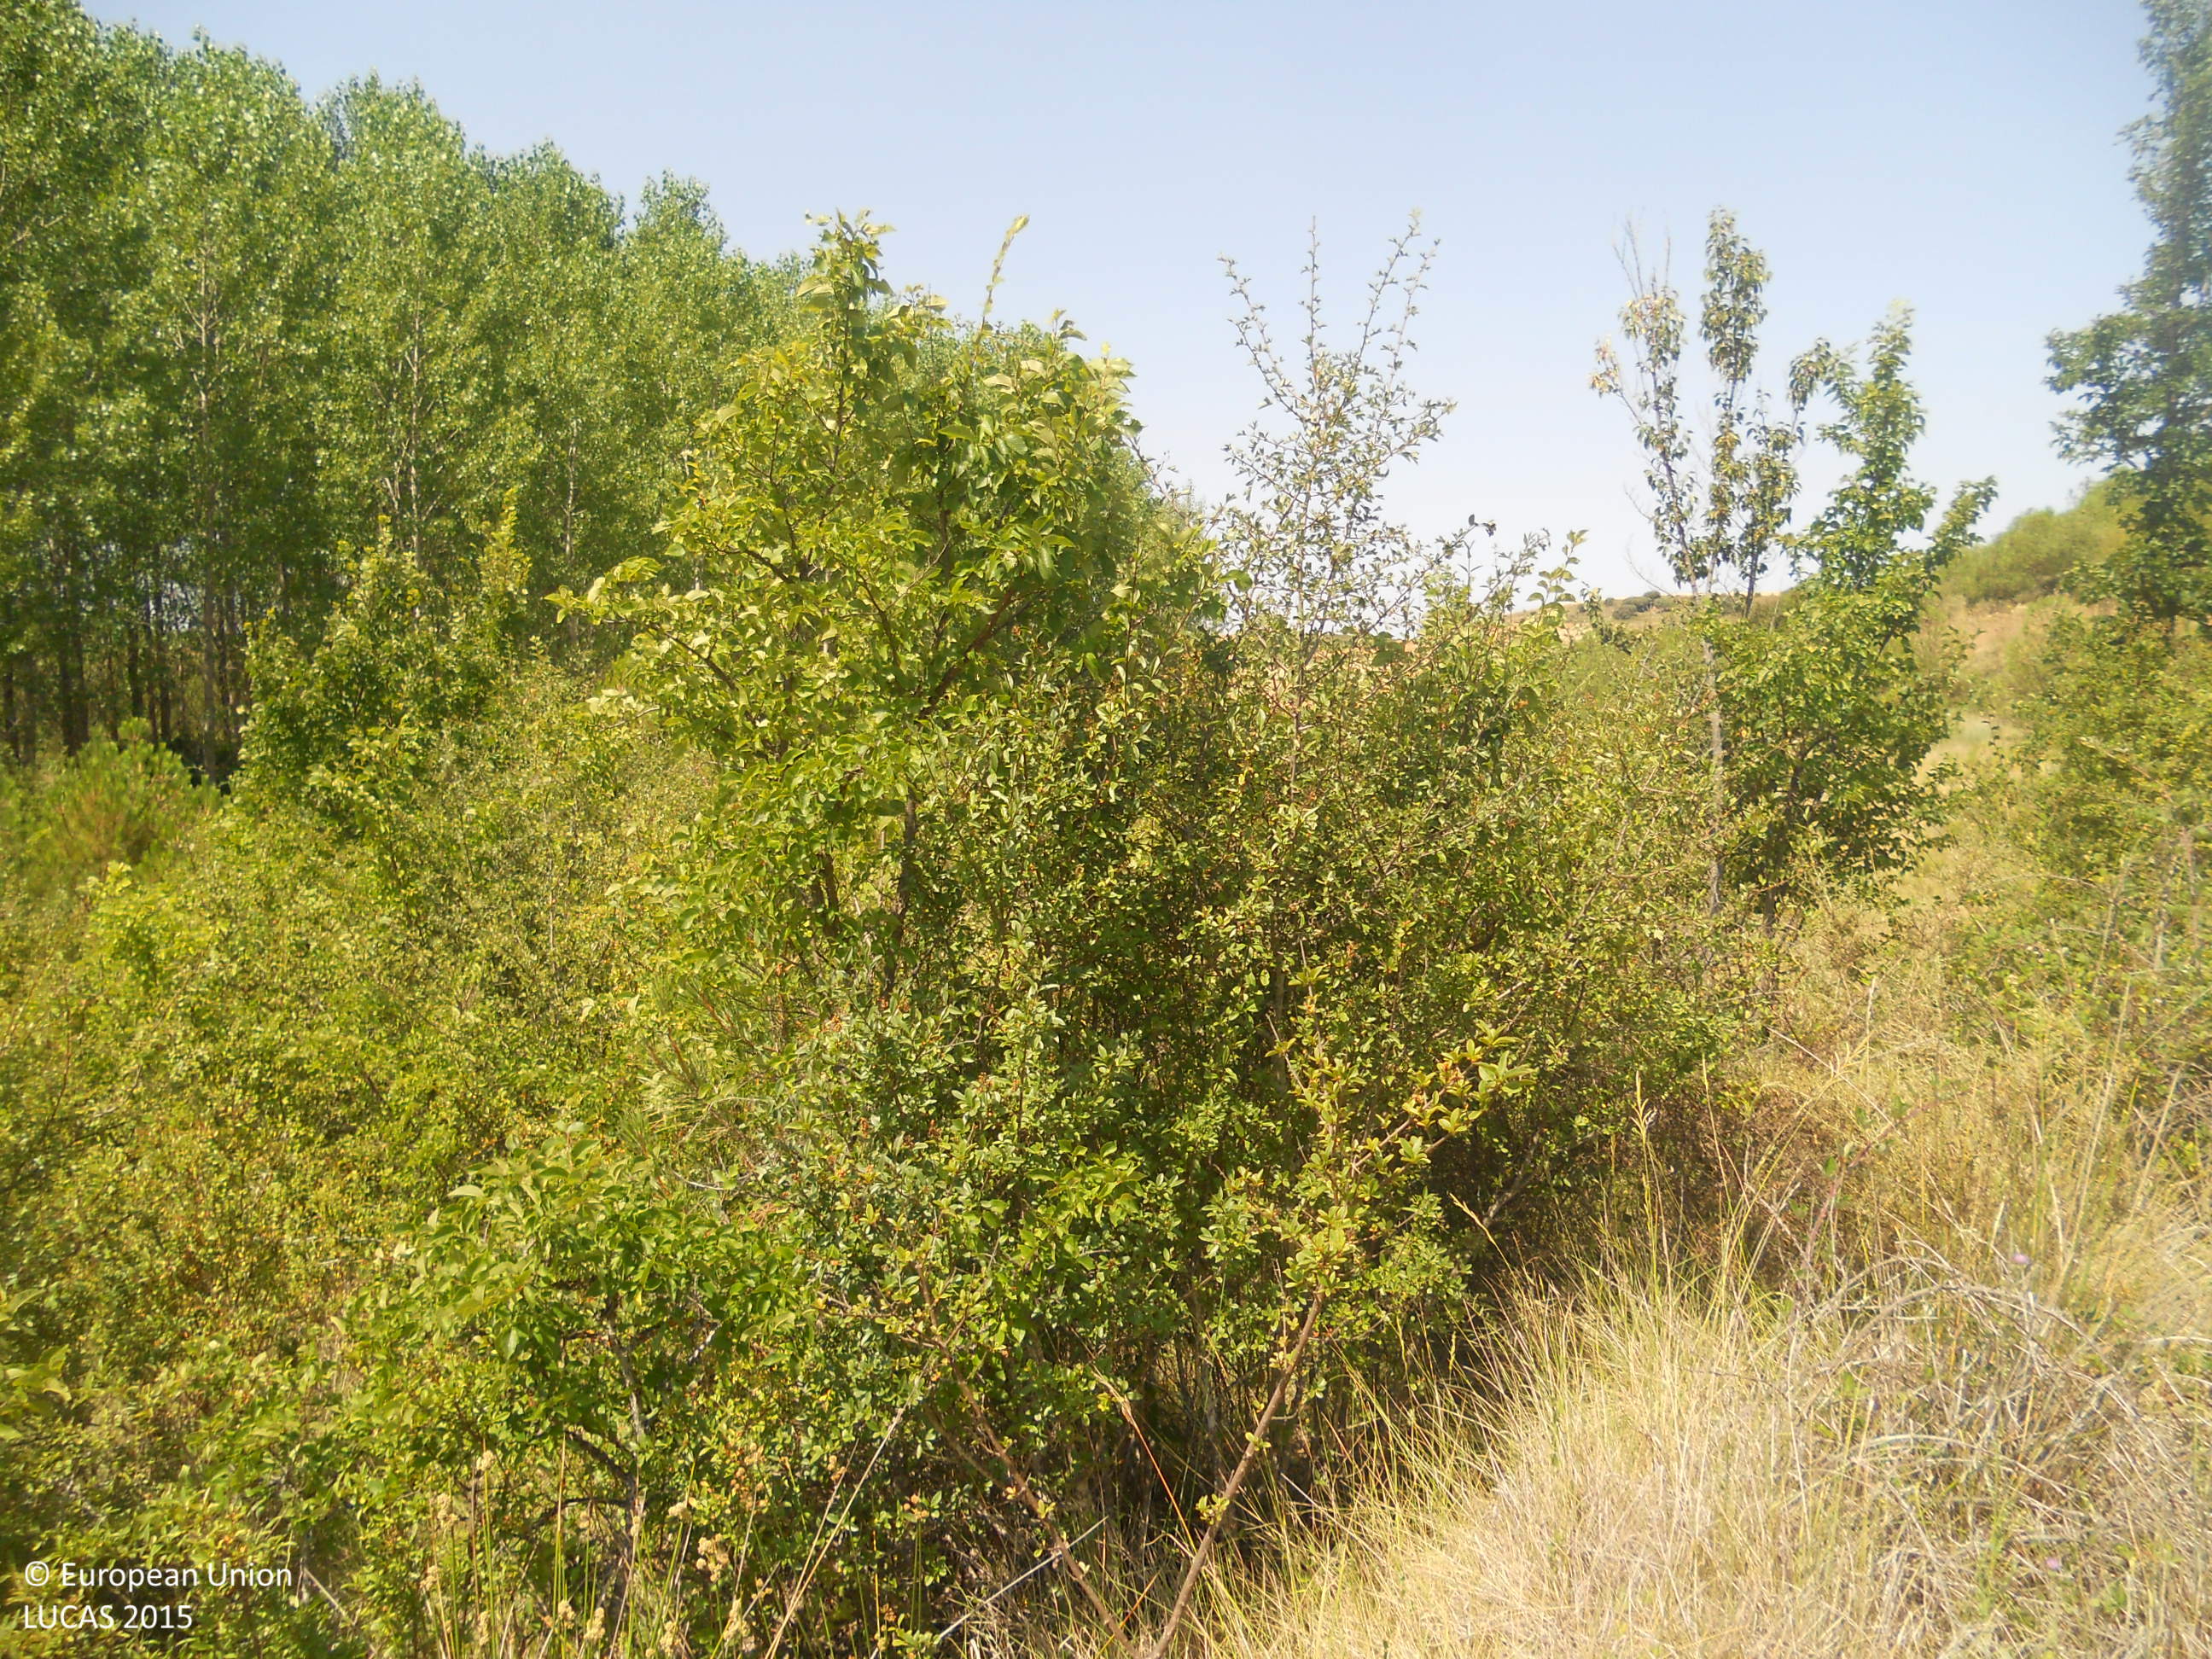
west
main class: Shrubland
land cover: Shrubland with sparse tree cover
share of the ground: > 75 %
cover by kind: shrubs 55 %, herbaceous plants 40 %, coniferous forest trees 5 %
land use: Semi-natural and natural areas not in use
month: July
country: ES
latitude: 42.5932
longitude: -5.3627
